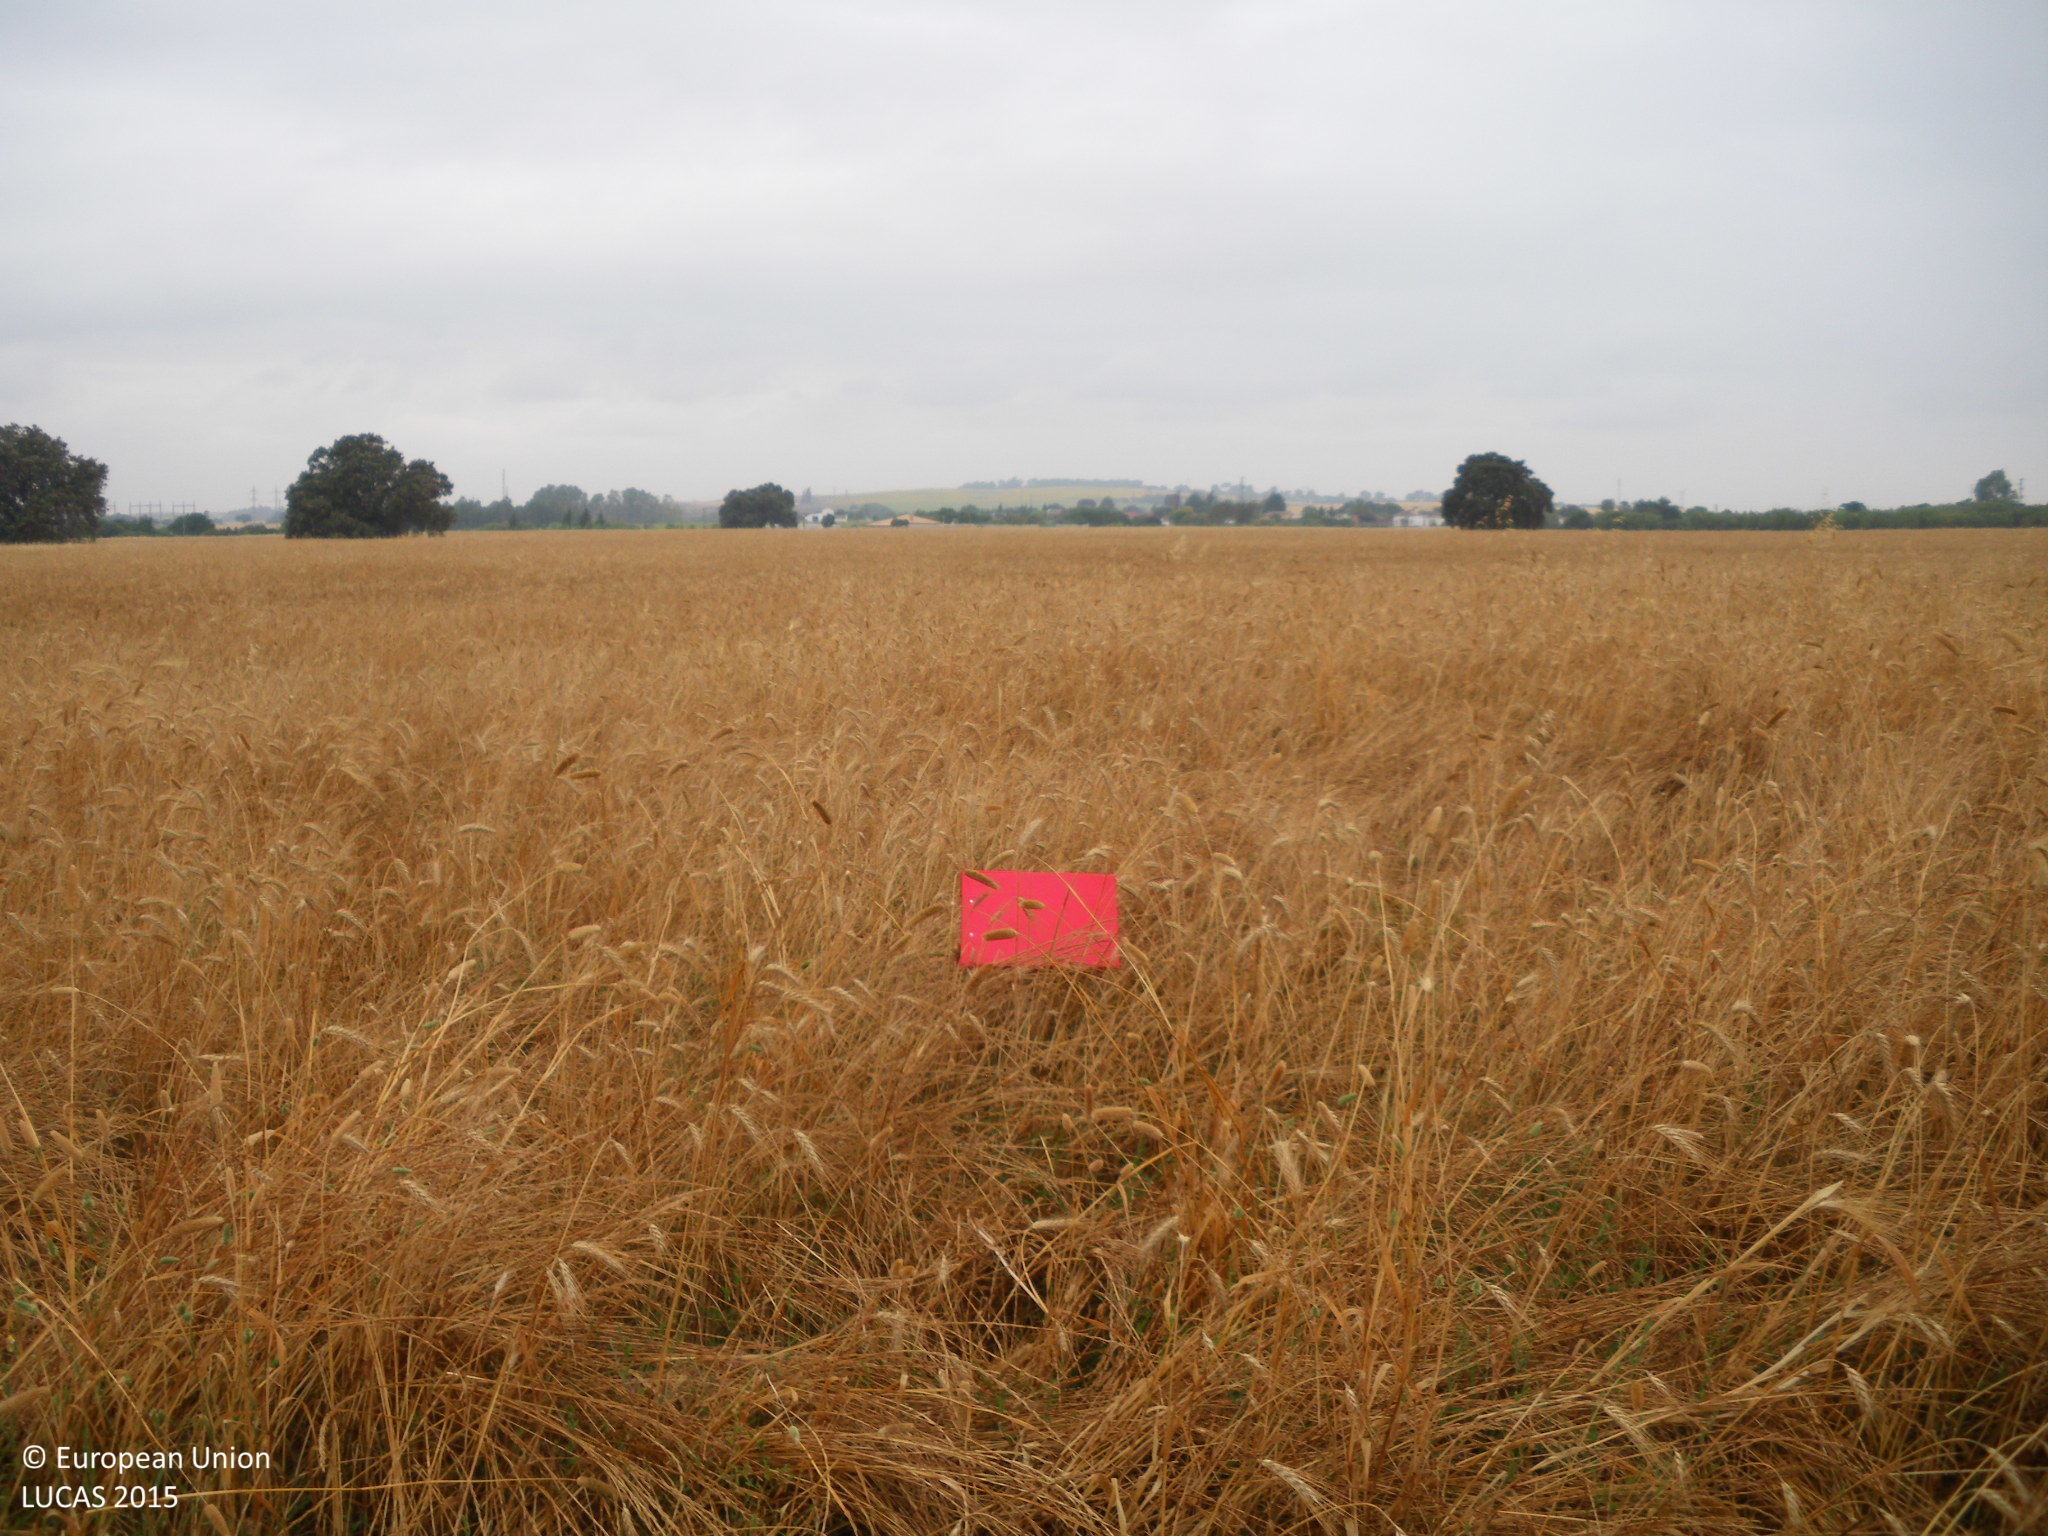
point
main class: Cropland
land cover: Barley
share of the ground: > 75 %
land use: Agriculture (excluding fallow land and kitchen gardens)
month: June
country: ES
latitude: 36.6643
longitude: -5.9746
